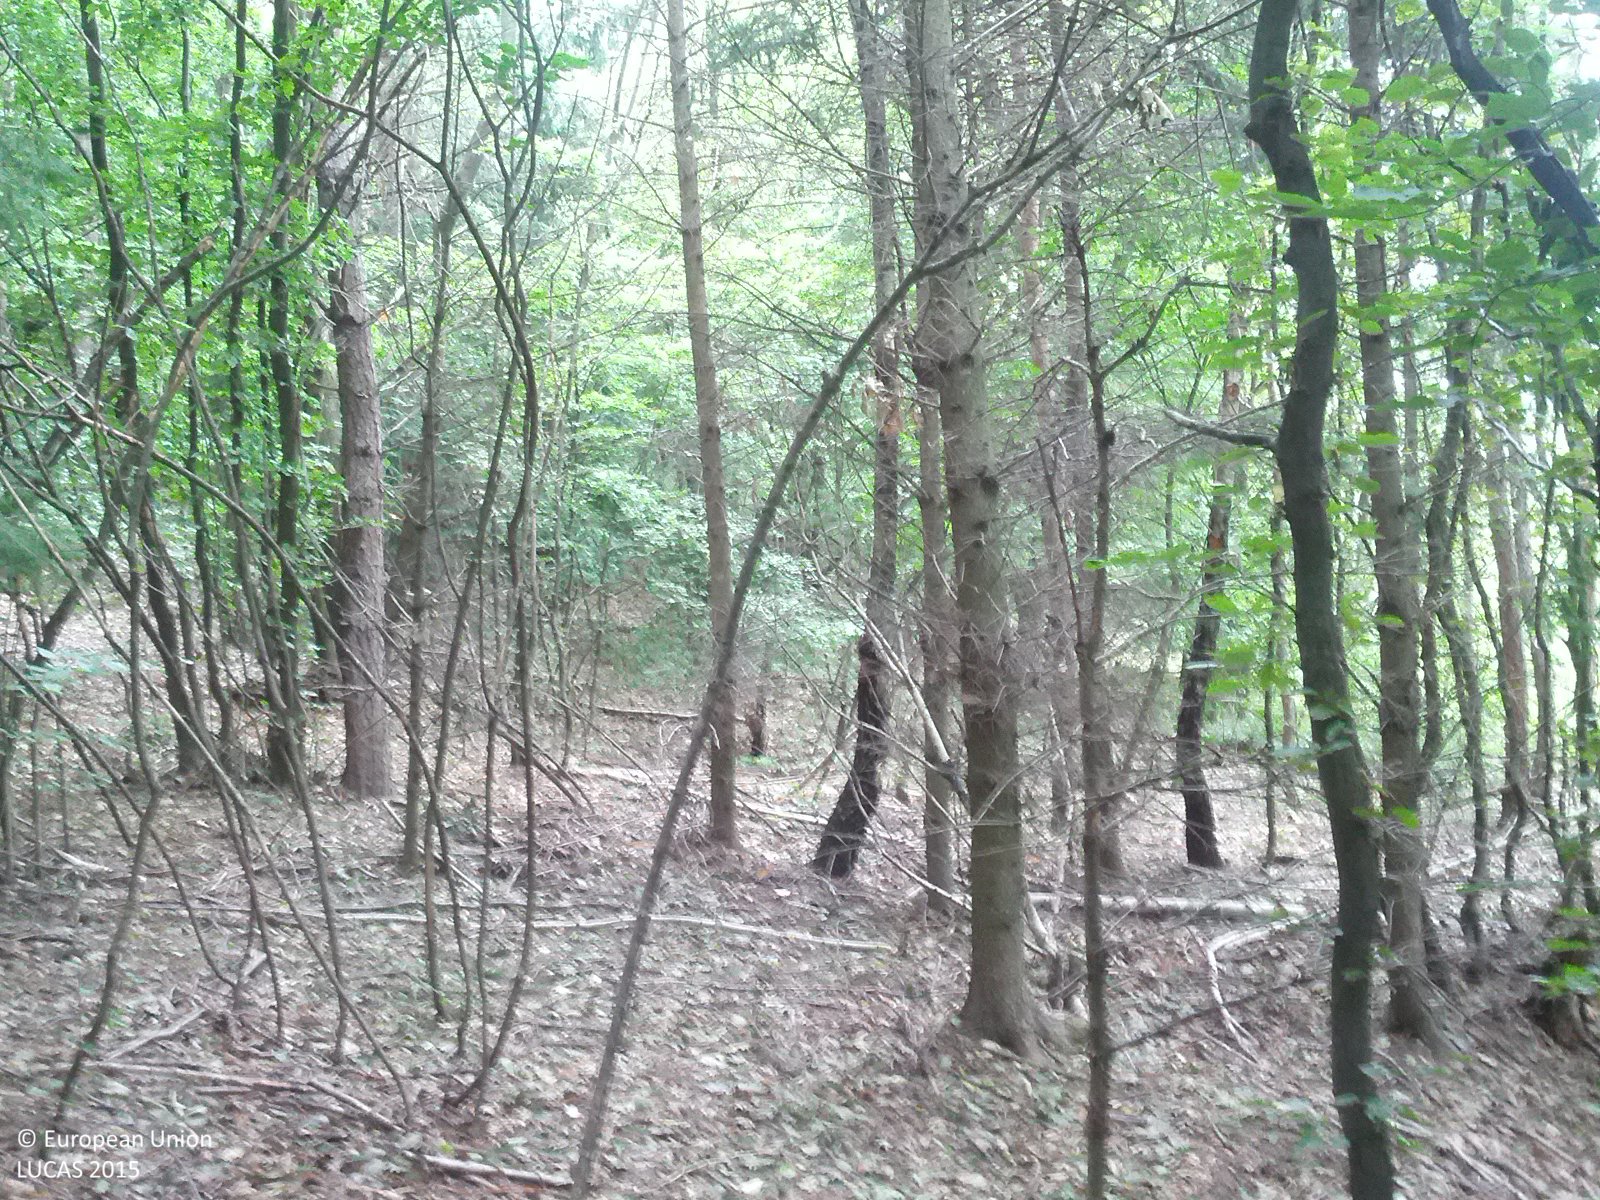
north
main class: Woodland
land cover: Spruce dominated mixed woodland
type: alpine coniferous forest
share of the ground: > 75 %
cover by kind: coniferous forest trees 55 %, broadleaved forest trees 35 %, shrubs 5 %, unconsolidated bare surface 5 %
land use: Forestry
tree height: > 5 m
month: July
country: AT
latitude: 47.3143
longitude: 16.4190
